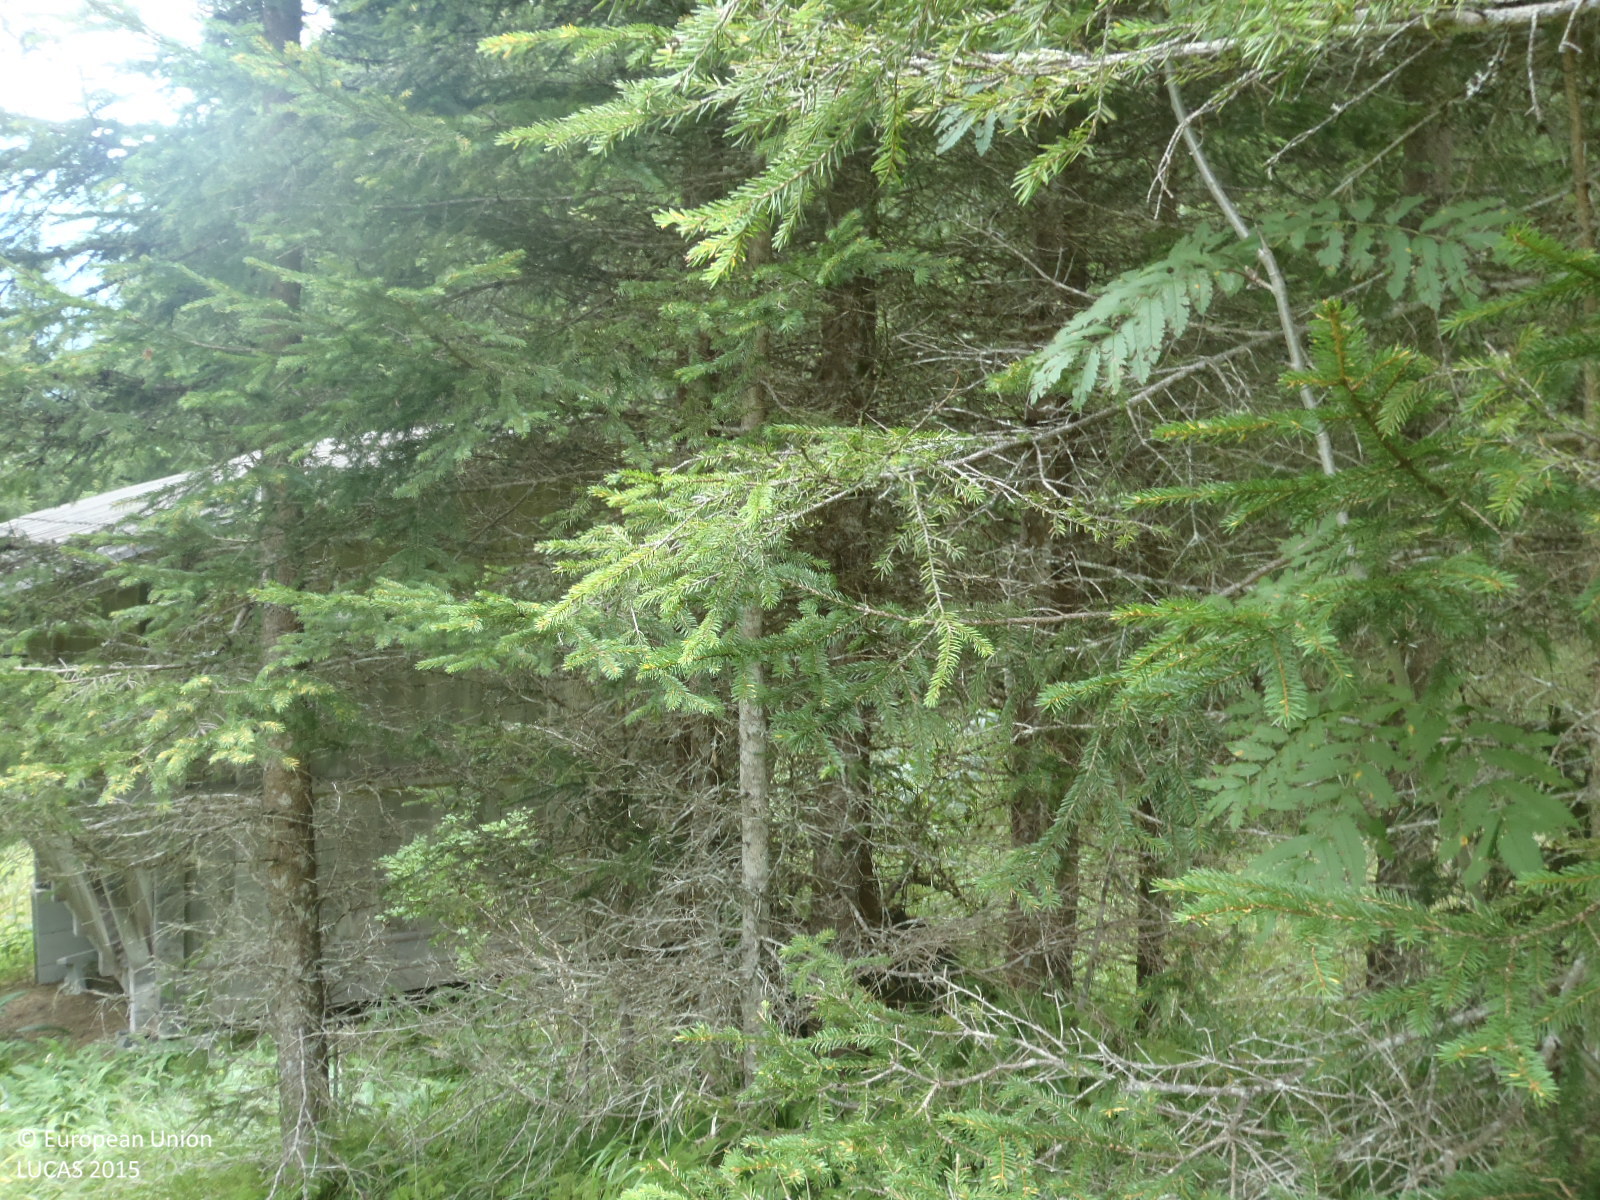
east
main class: Woodland
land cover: Spruce dominated coniferous woodland
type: alpine coniferous forest
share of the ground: > 75 %
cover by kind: coniferous forest trees 95 %, herbaceous plants 5 %
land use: Forestry
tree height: > 5 m
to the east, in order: Spruce dominated coniferous woodland; Artificial constructions in urban areas; Spruce dominated coniferous woodland; Artificial constructions; Spruce dominated coniferous woodland; Fences; Spruce dominated coniferous woodland
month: August
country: AT
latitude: 46.9183
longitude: 12.4271
